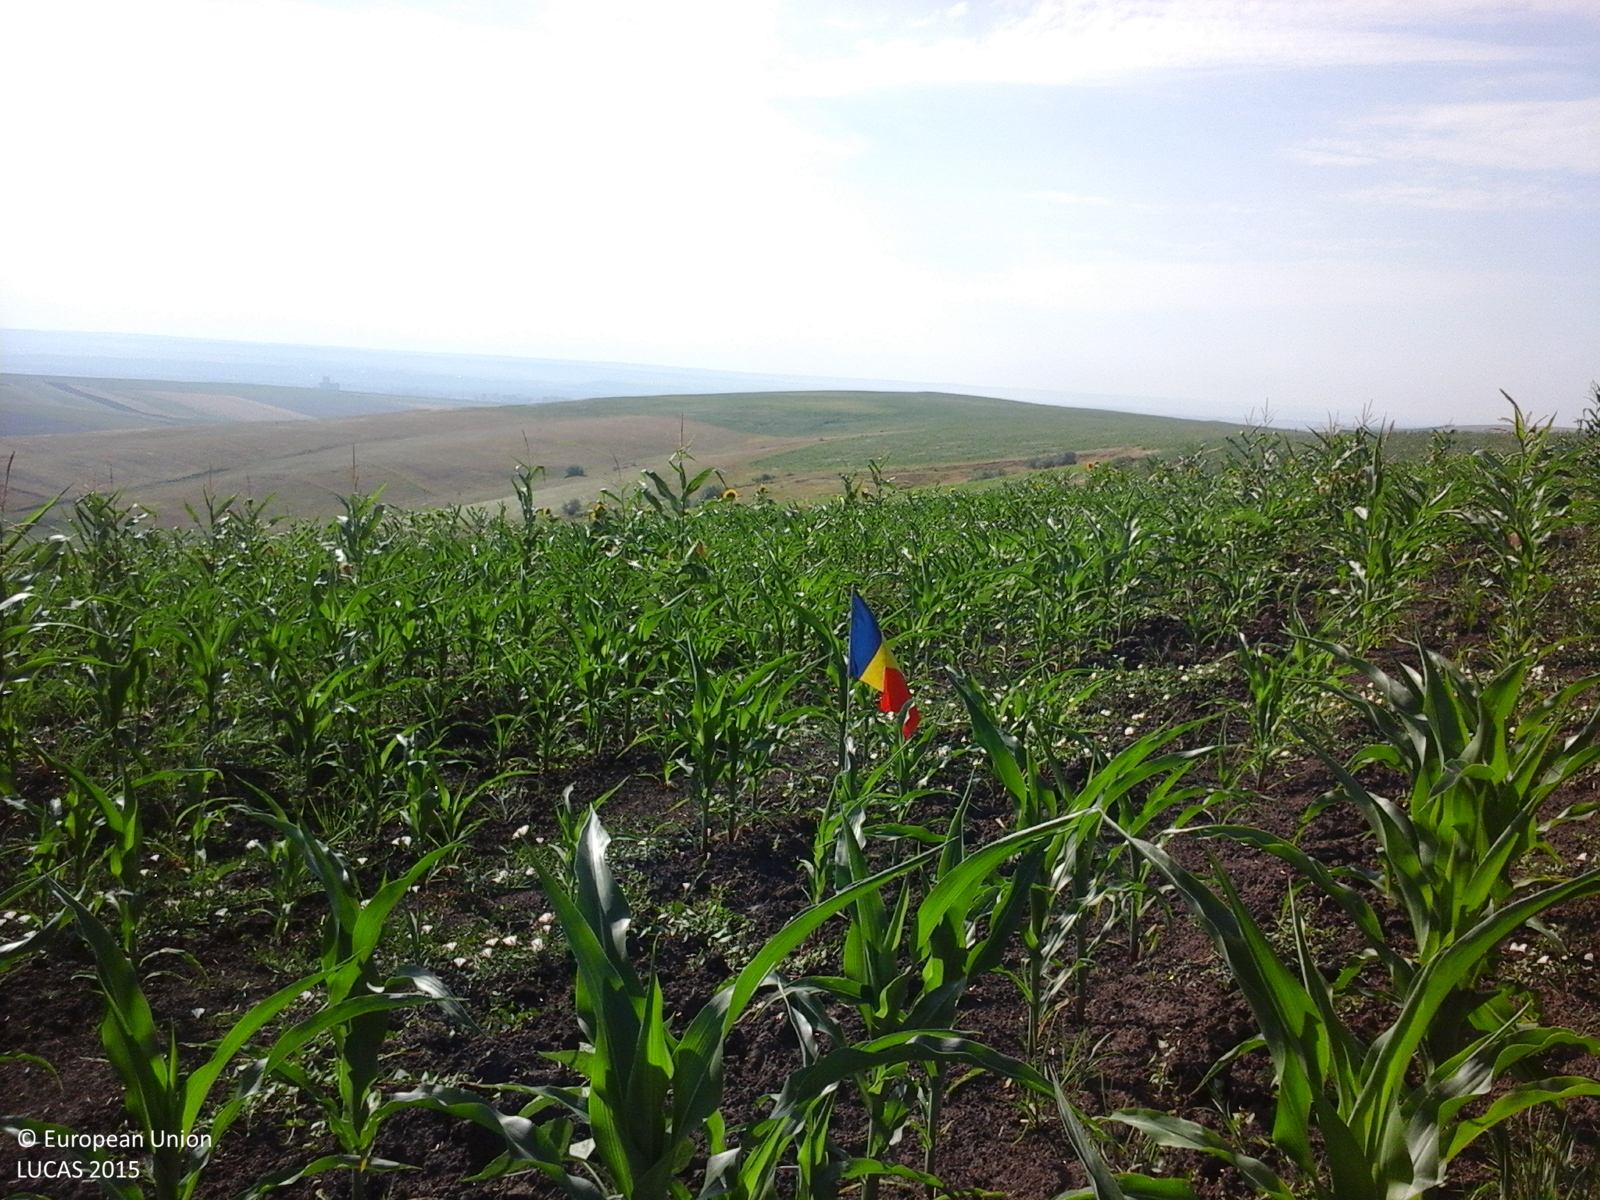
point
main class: Cropland
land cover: Maize
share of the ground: 50 - 75 %
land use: Agriculture (excluding fallow land and kitchen gardens)
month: July
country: RO
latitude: 46.2747
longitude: 28.0470
